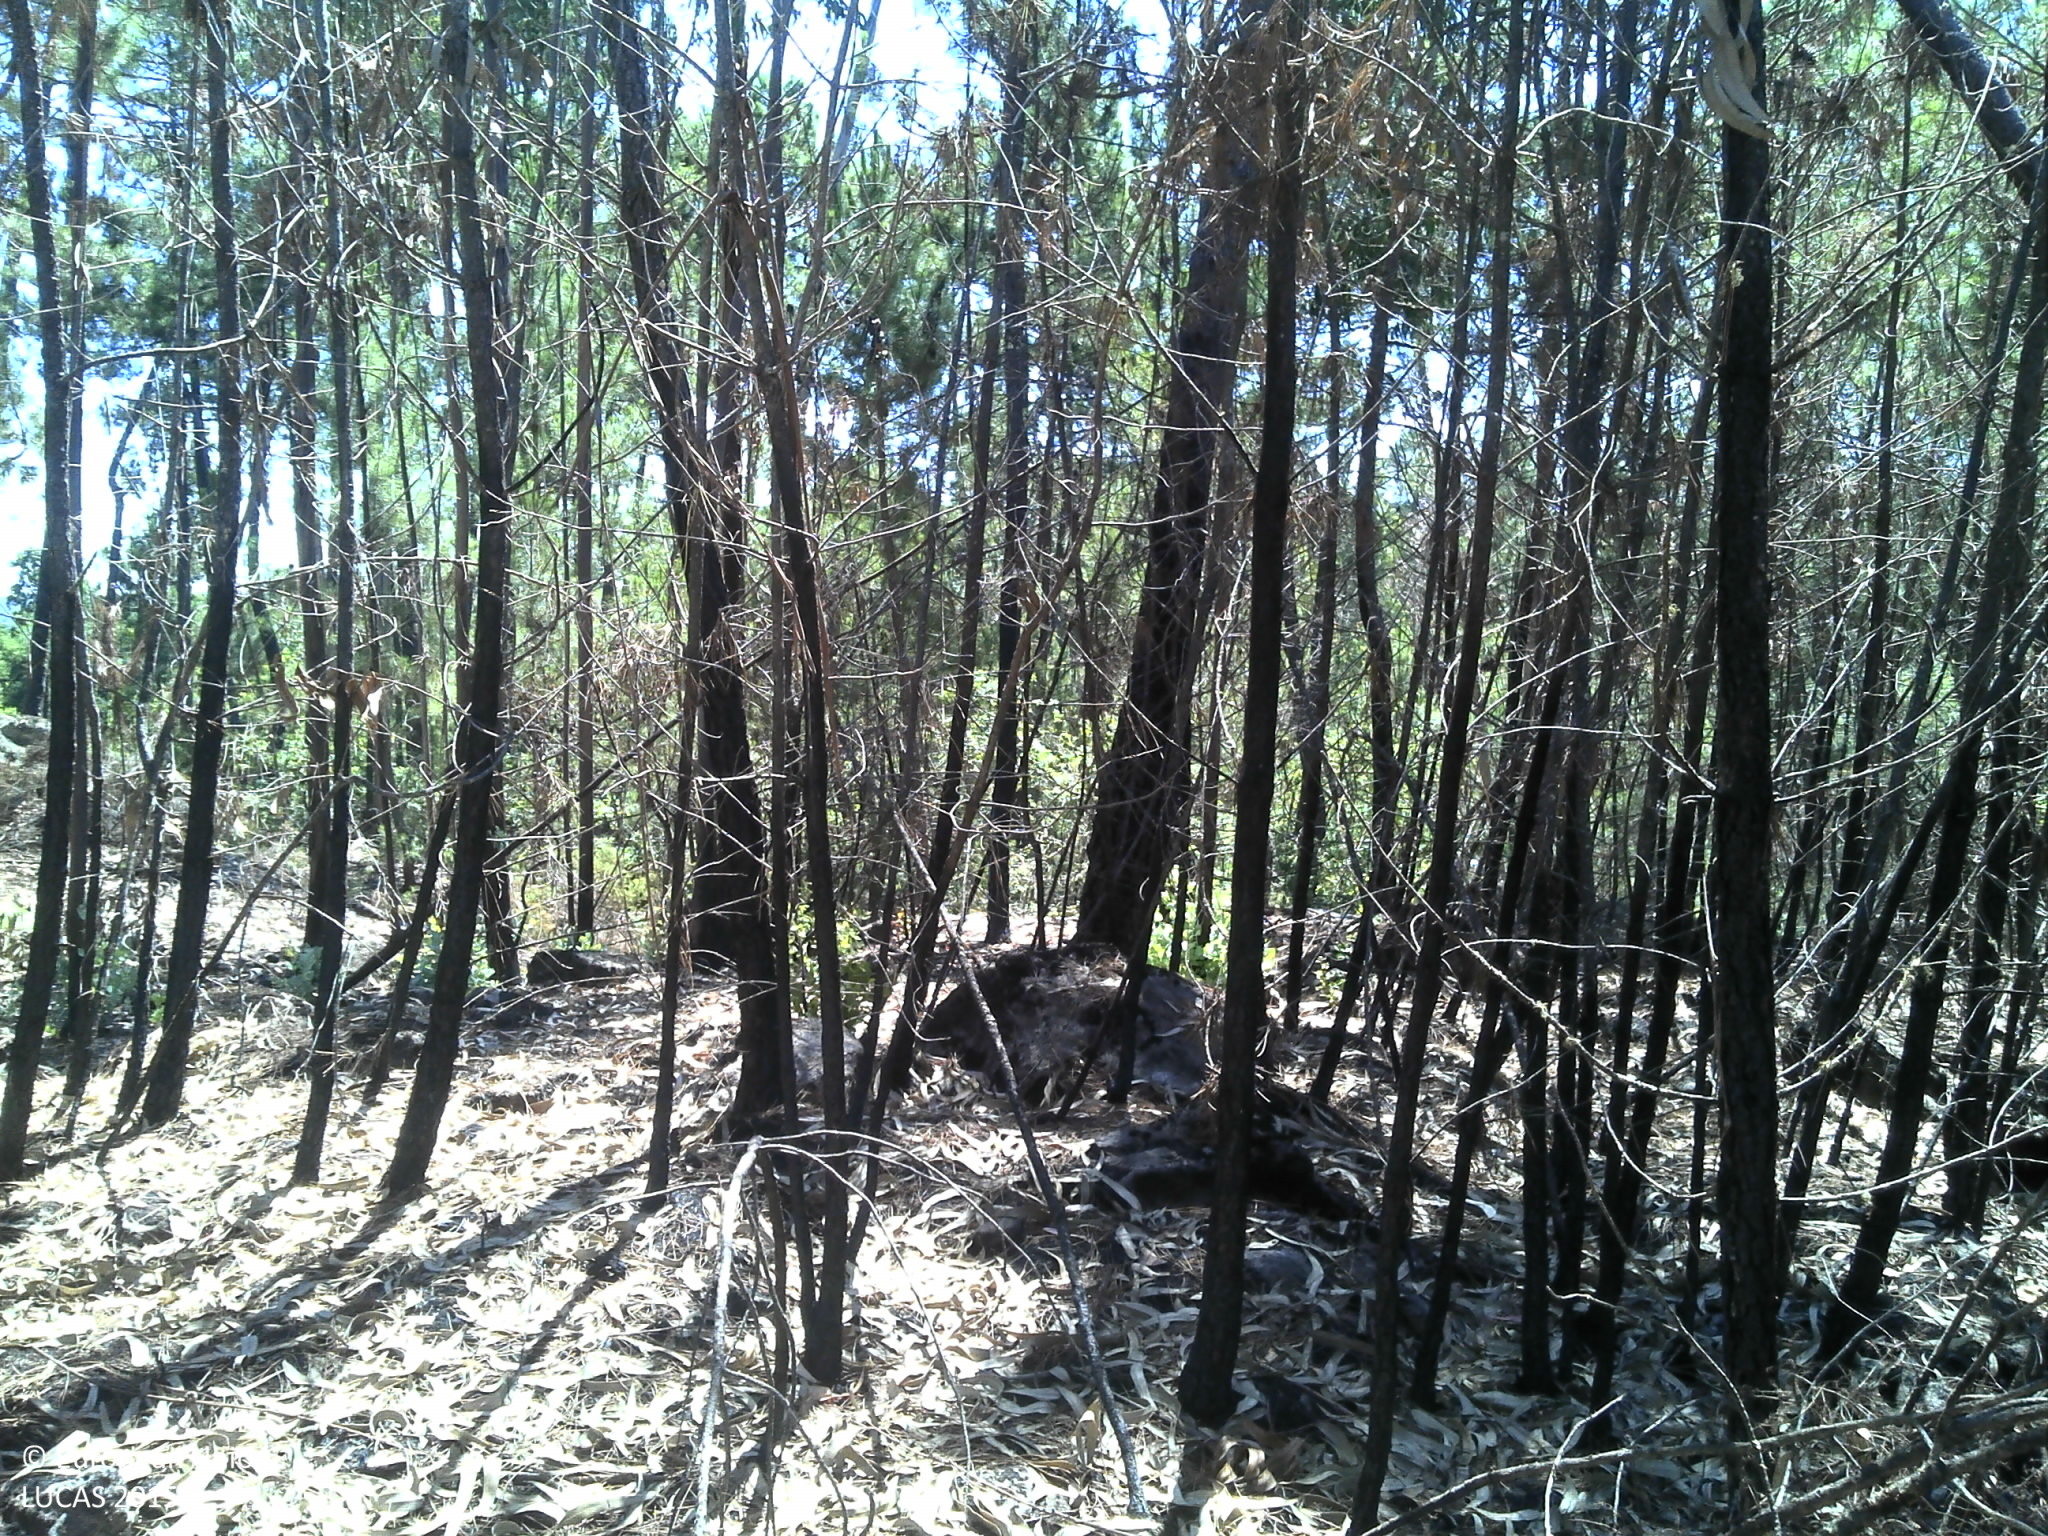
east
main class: Woodland
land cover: Pine dominated mixed woodland
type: coniferous forest of the mediterranean region
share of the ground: 50 - 75 %
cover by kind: coniferous forest trees 50 %, broadleaved forest trees 25 %, unconsolidated bare surface 20 %, consolidated bare surface 5 %
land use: Forestry
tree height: > 5 m
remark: Burnt area
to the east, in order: Pine dominated mixed woodland; Broadleaved woodland; Pine dominated coniferous woodland; Shrubland with sparse tree cover; Broadleaved woodland; Pine dominated coniferous woodland
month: June
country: PT
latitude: 40.6525
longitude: -8.0208
